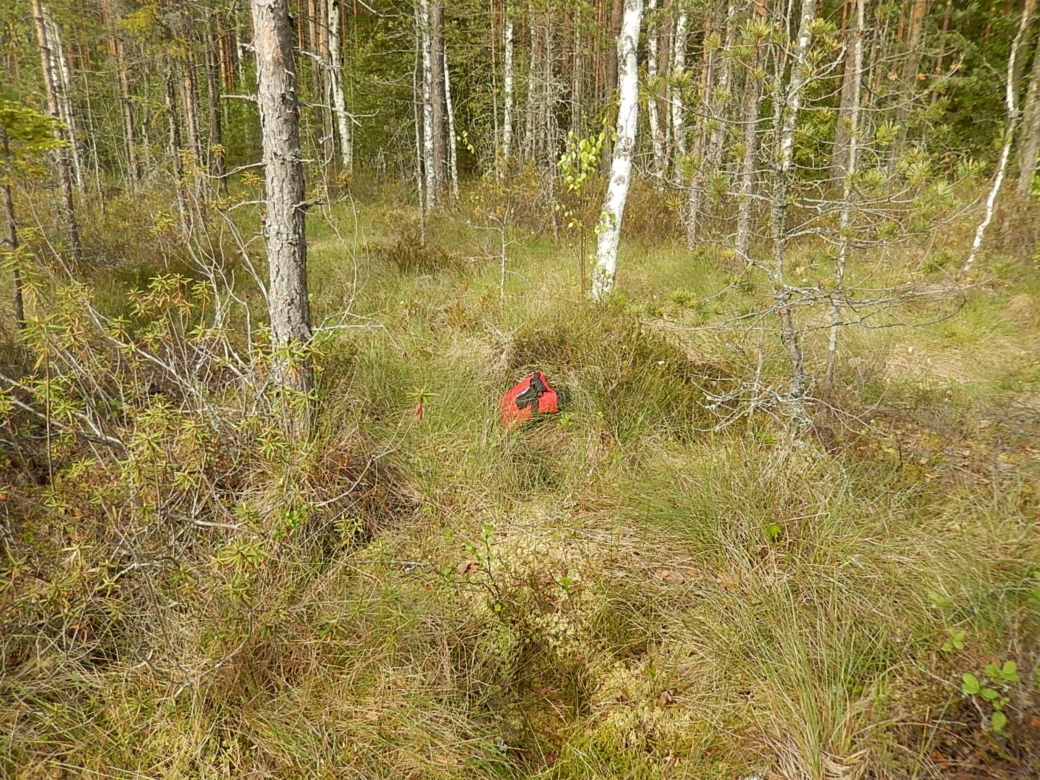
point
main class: Woodland
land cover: Pine dominated mixed woodland
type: boreal forest
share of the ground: > 75 %
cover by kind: coniferous forest trees 50 %, broadleaved forest trees 30 %, shrubs 10 %, herbaceous plants 10 %
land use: Forestry
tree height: > 5 m
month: June
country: FI
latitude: 61.9480
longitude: 21.5418
